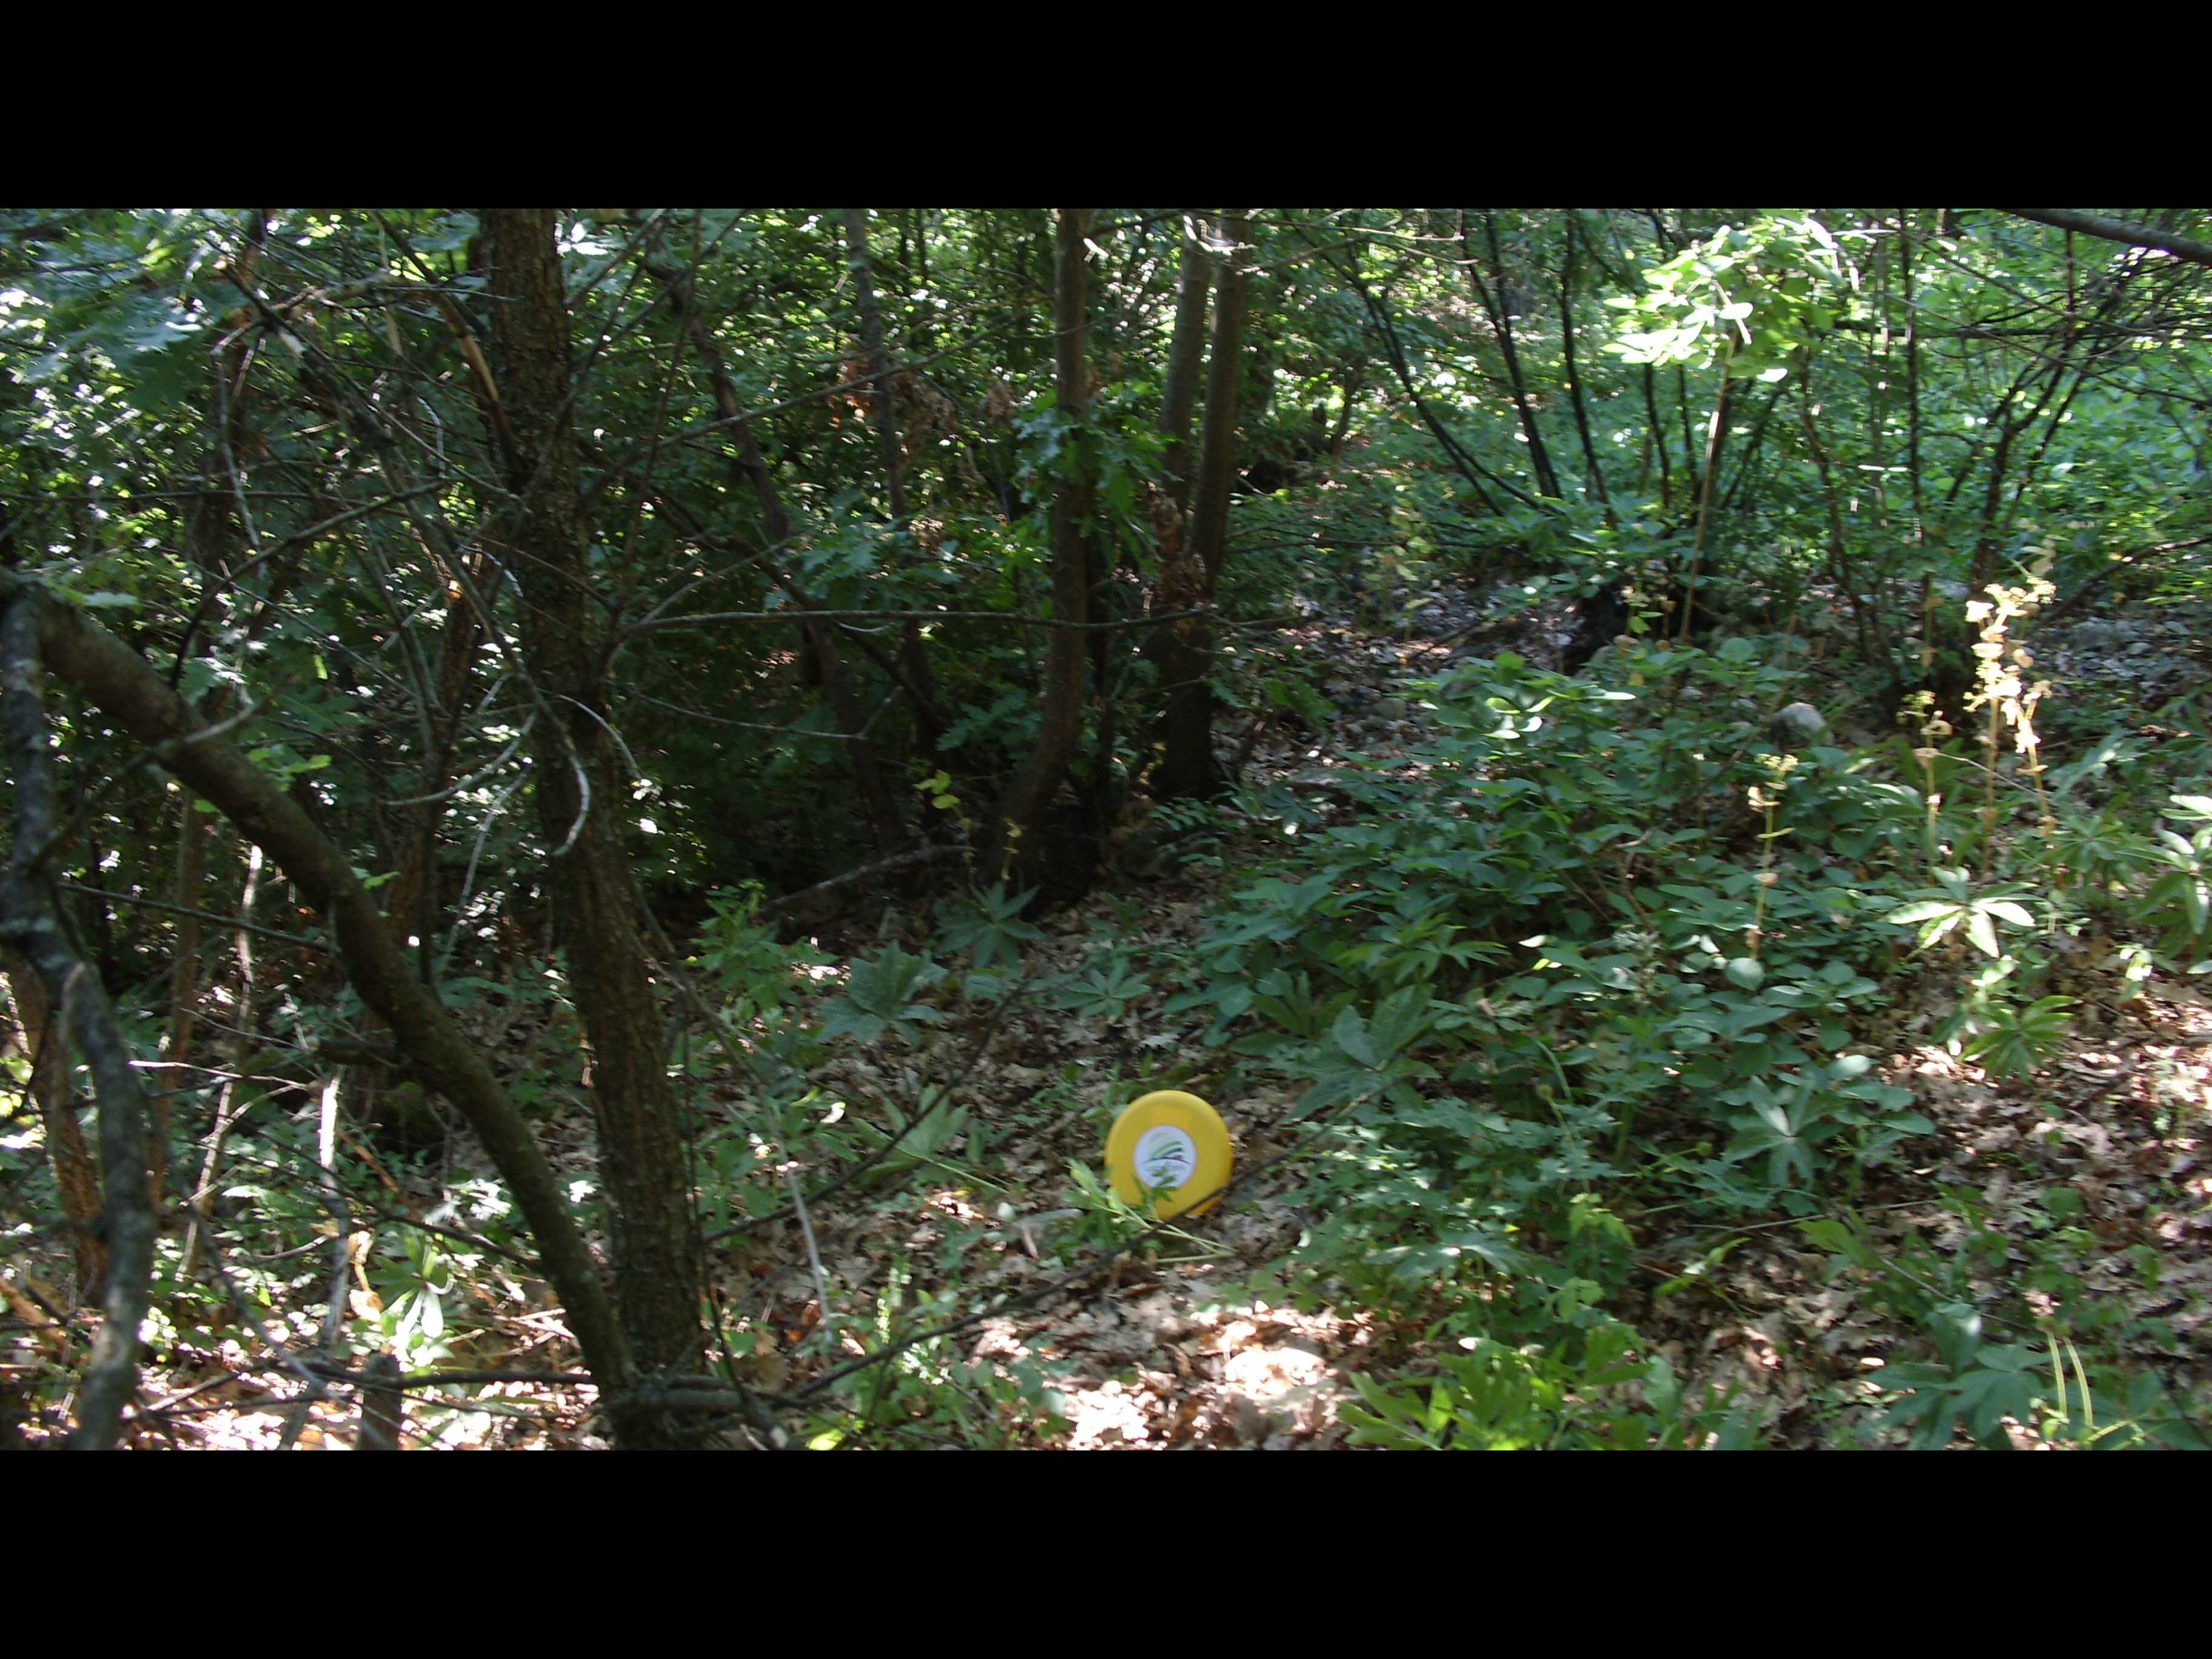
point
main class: Woodland
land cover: Broadleaved woodland
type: mesophytic deciduous forest
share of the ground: > 75 %
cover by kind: broadleaved forest trees 95 %, shrubs 5 %
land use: Forestry
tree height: > 5 m
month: June
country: BG
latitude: 43.4776
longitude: 23.5329
